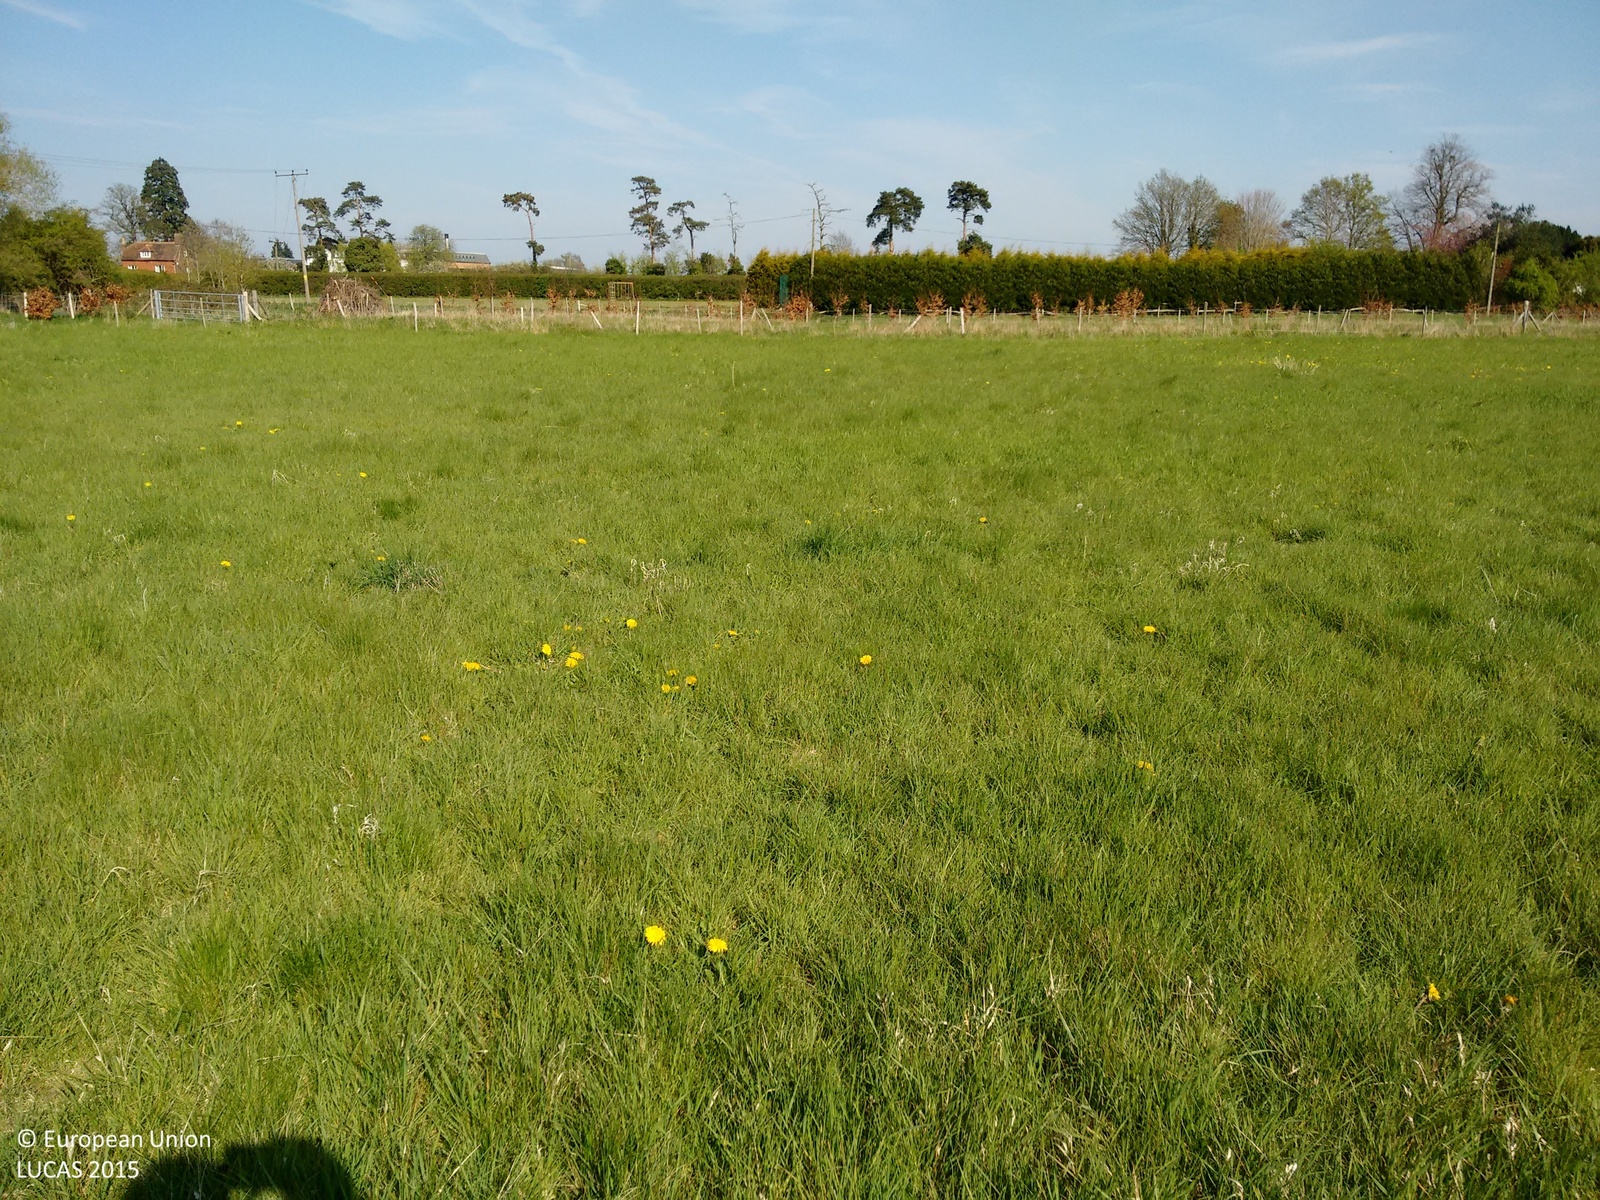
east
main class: Grassland
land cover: Grassland without tree/shrub cover
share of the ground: > 75 %
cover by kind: herbaceous plants 100 %
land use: Agriculture (excluding fallow land and kitchen gardens)
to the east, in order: Grassland without tree/shrub cover; Fences; Tracks; Fences; Grassland without tree/shrub cover; Fences; Grassland without tree/shrub cover; Artificial constructions in urban areas; Grassland without tree/shrub cover; Managed hedges; Grass margins; Paved roads, cycling and walking lanes; Grass margins; Managed hedges; Ditches and canals; Spontaneously vegetated surfaces; Dry pulses
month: April
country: GB
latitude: 51.2062
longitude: 0.3666
